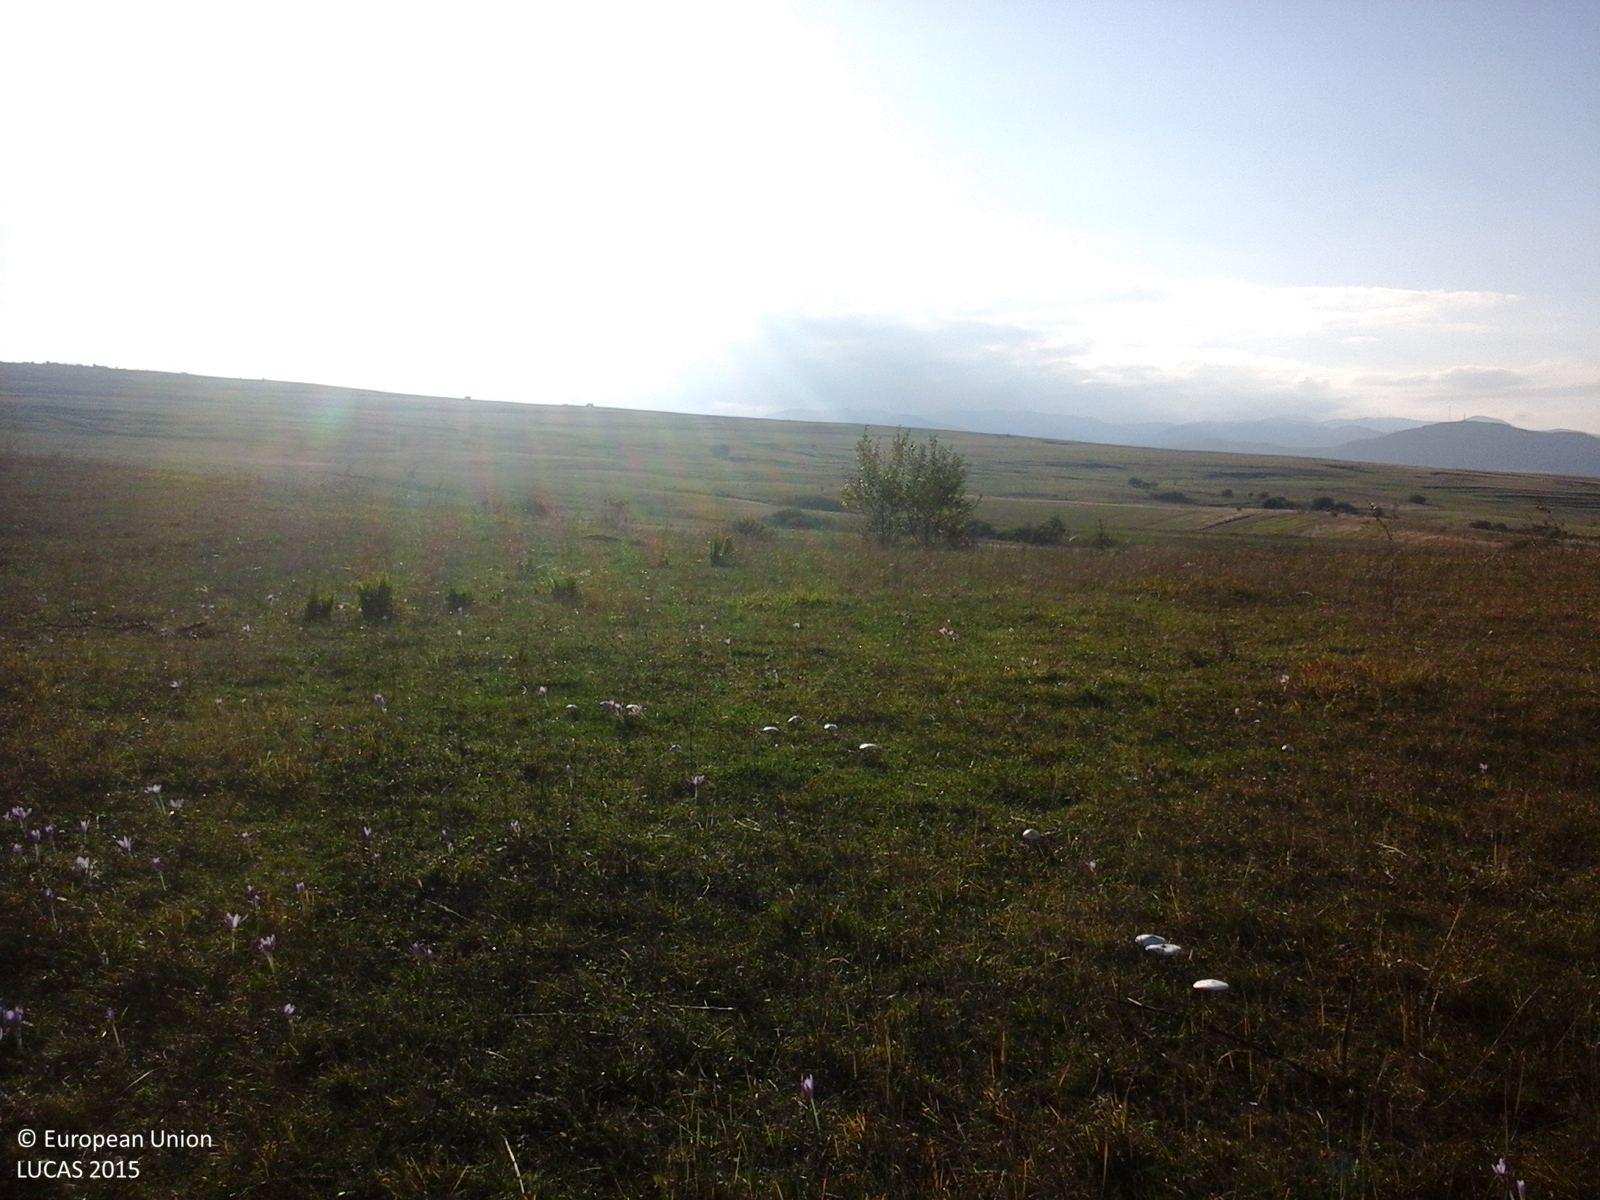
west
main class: Grassland
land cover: Grassland with sparse tree/shrub cover
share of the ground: > 75 %
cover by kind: herbaceous plants 85 %, shrubs 10 %, broadleaved forest trees 5 %
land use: Agriculture (excluding fallow land and kitchen gardens)
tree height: < 5 m
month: October
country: RO
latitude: 46.6036
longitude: 23.5021
